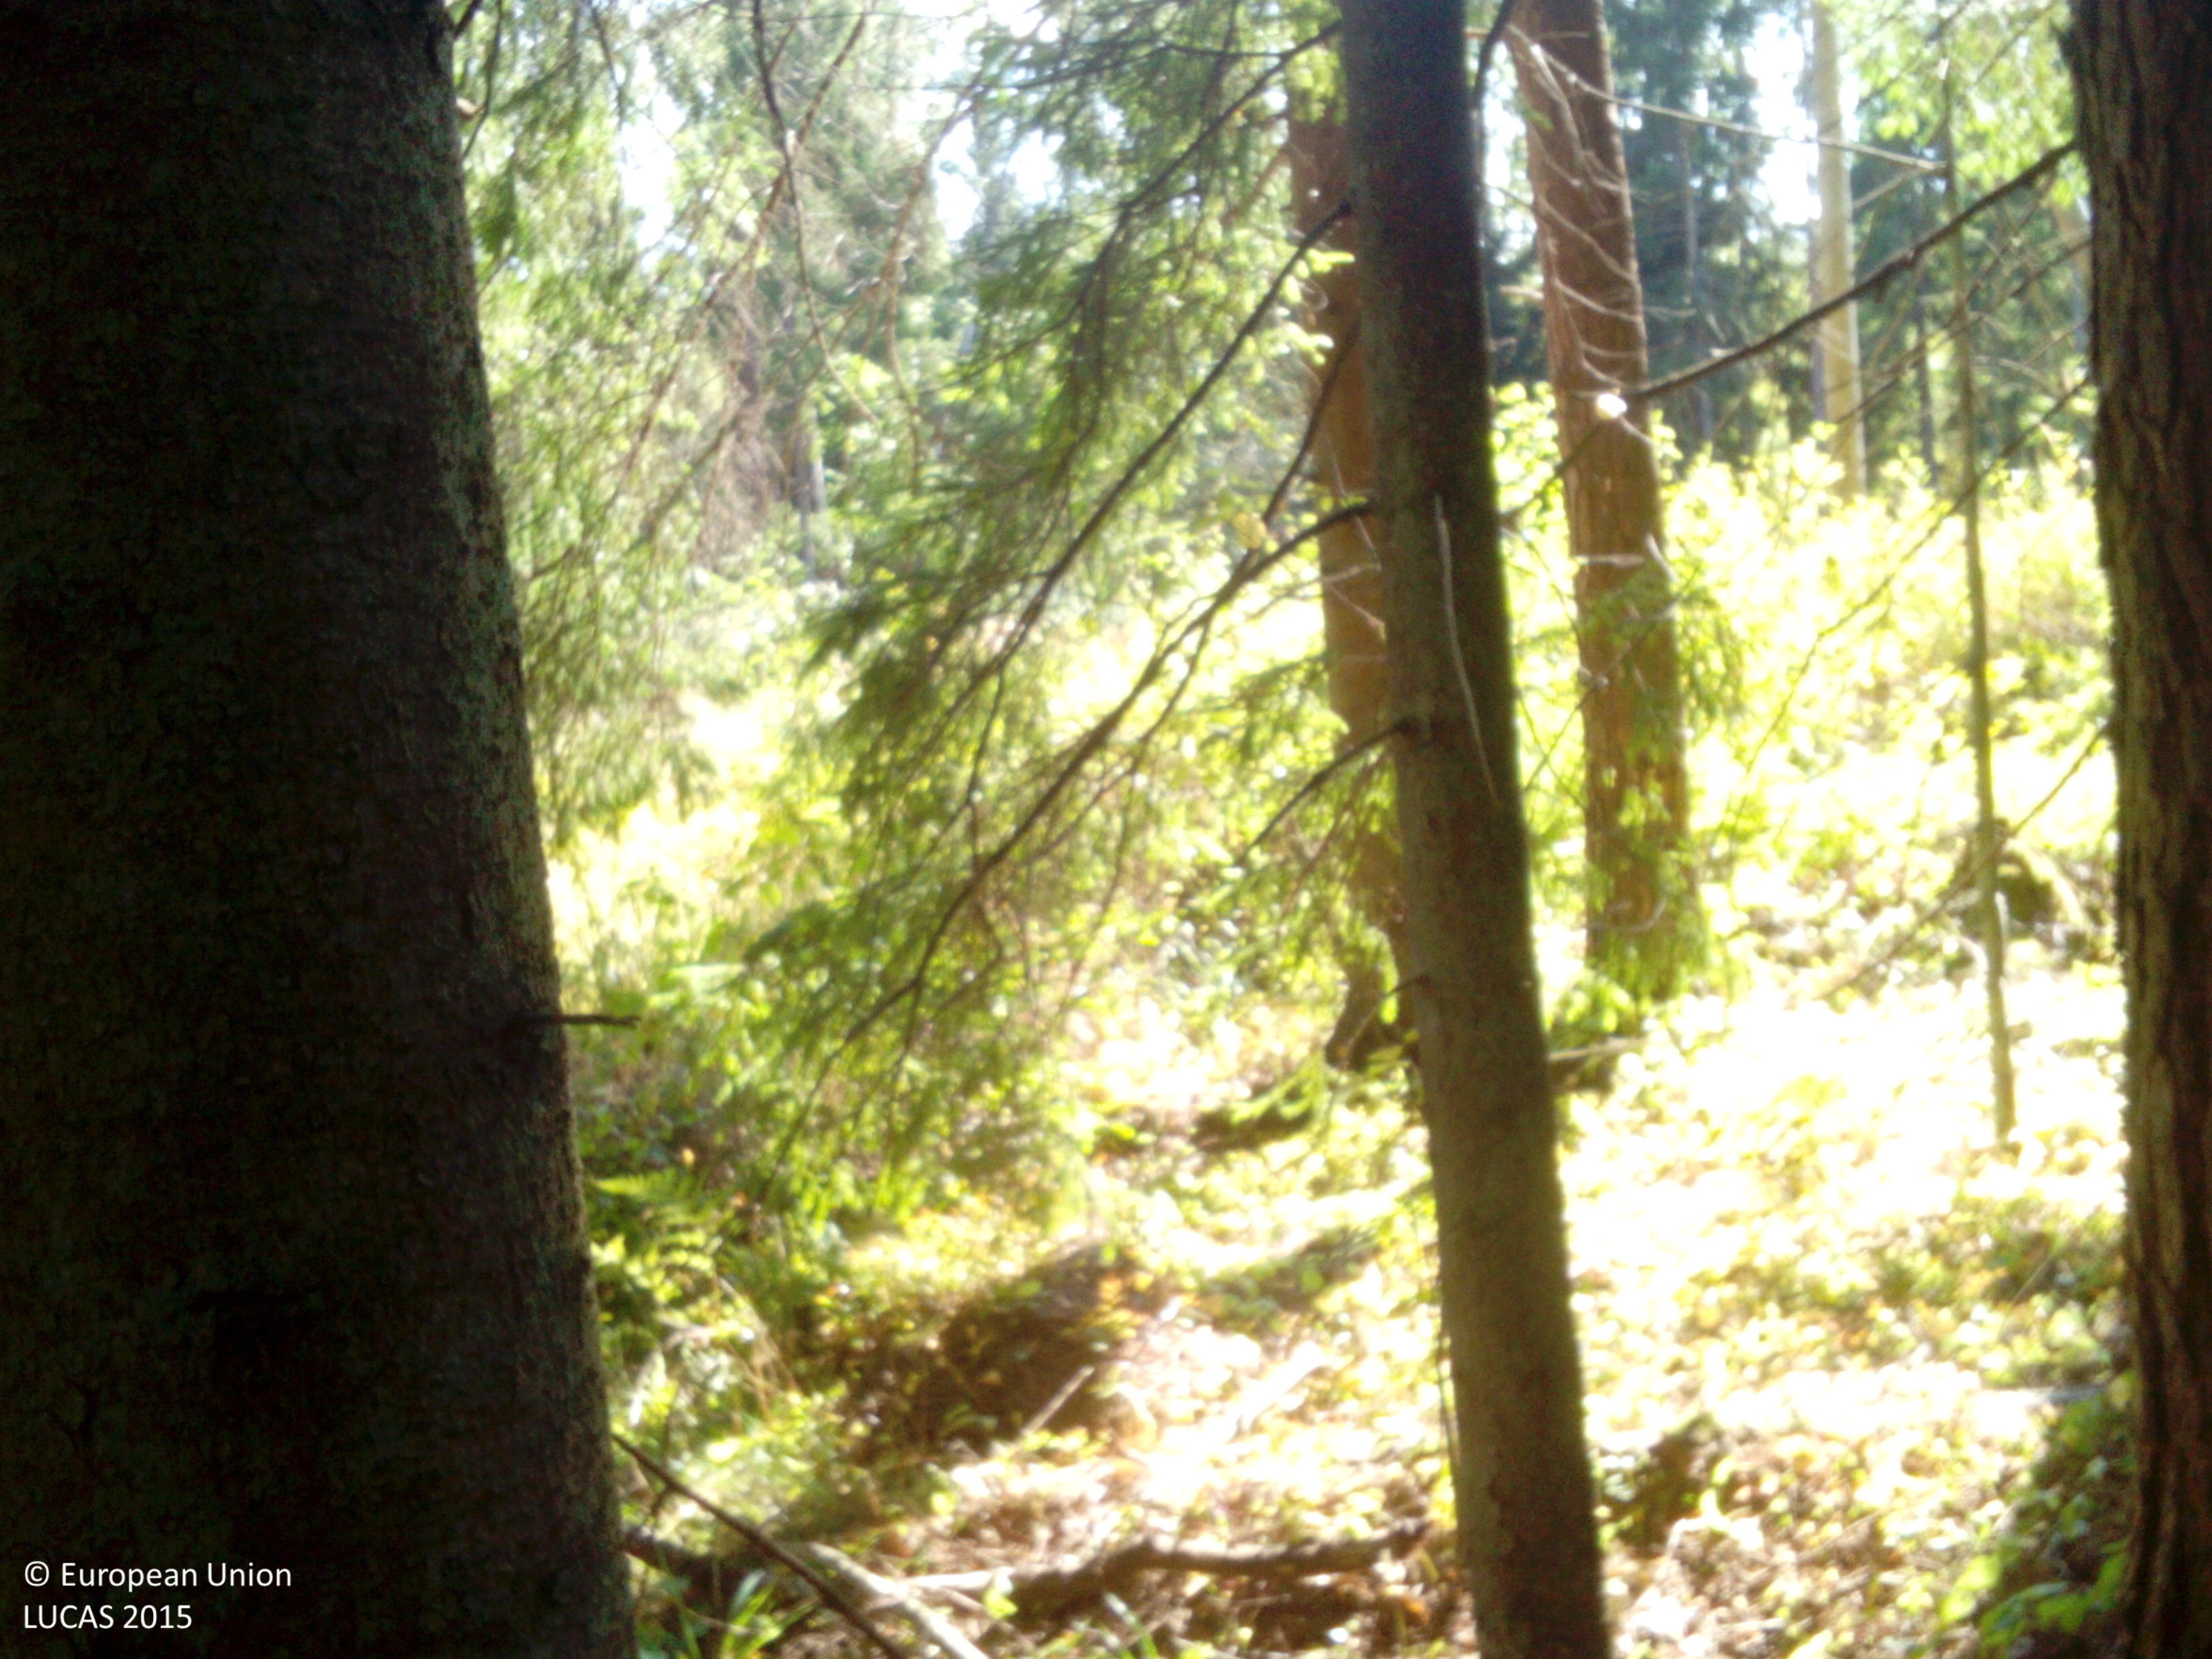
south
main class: Woodland
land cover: Other coniferous woodland
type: hemiboreal forest and nemoral coniferous forest and mixed broadleaved-coniferous forest
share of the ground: > 75 %
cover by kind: coniferous forest trees 85 %, herbaceous plants 10 %, unconsolidated bare surface 5 %
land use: Forestry
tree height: > 5 m
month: August
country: LV
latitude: 56.3659
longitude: 21.2251
